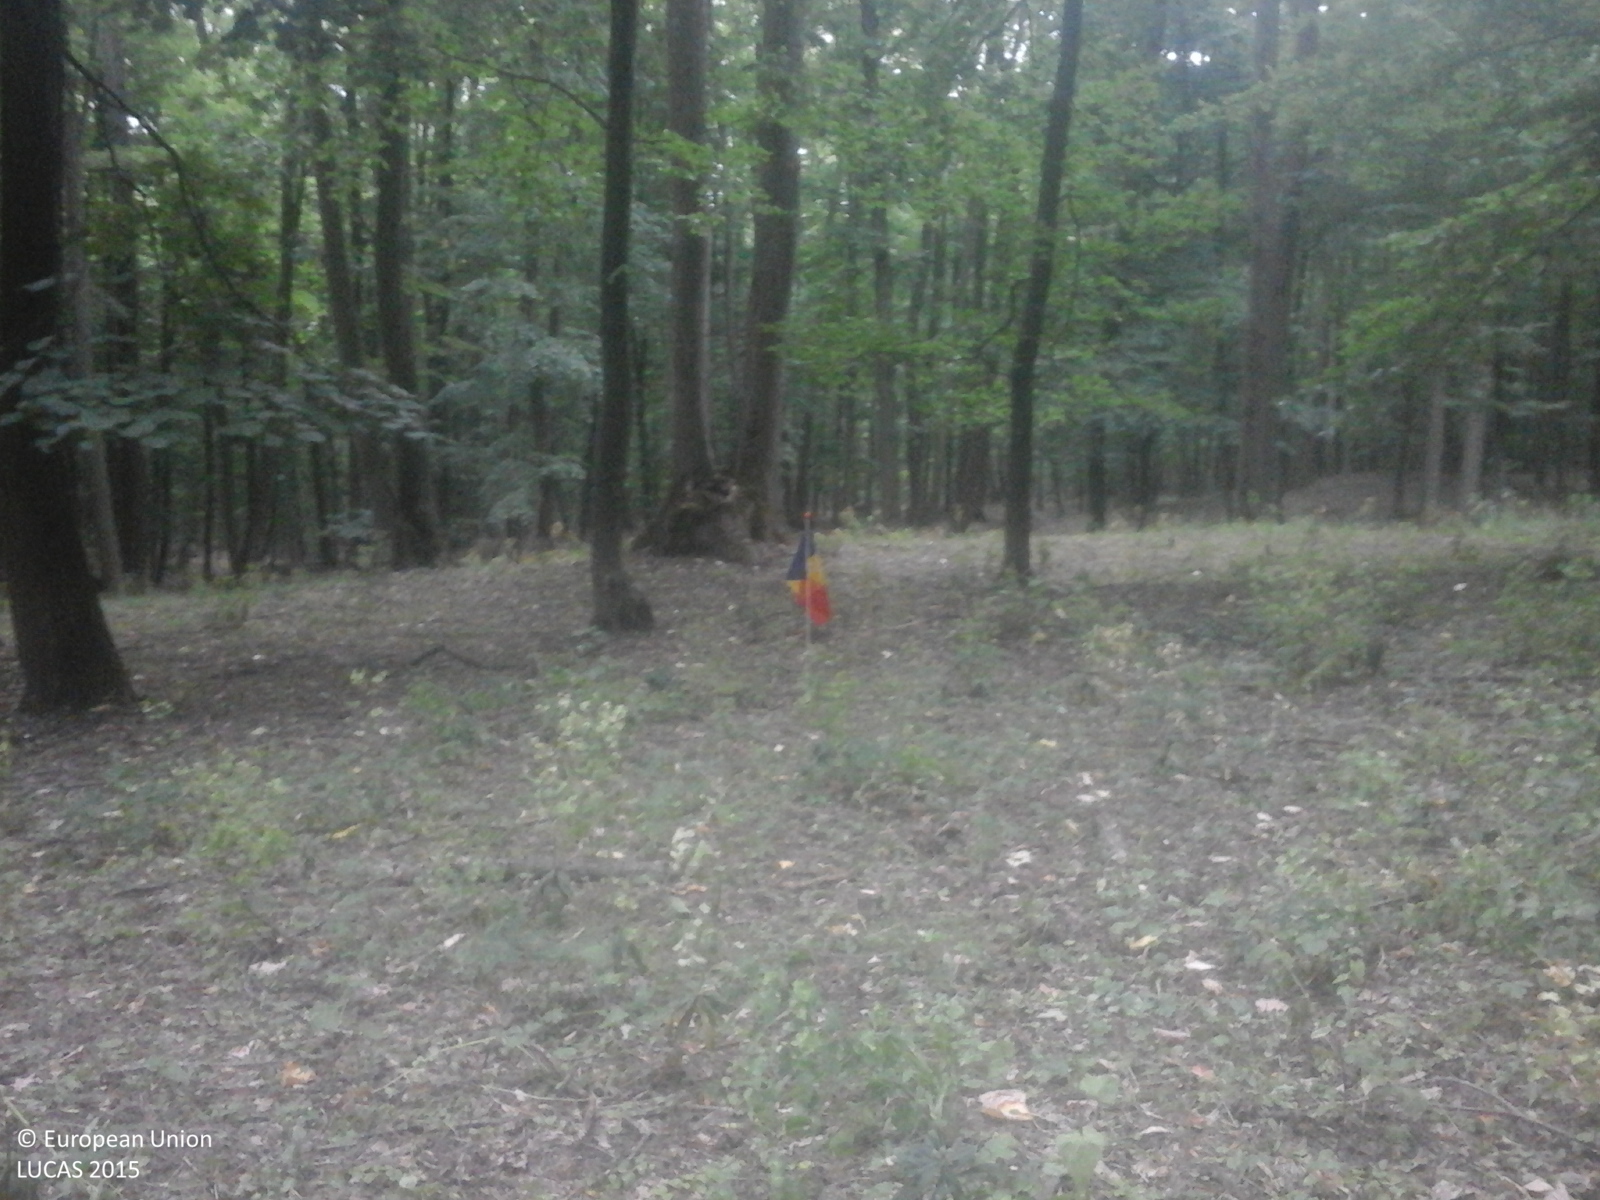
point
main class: Woodland
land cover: Broadleaved woodland
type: beech forest
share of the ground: > 75 %
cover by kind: broadleaved forest trees 95 %, herbaceous plants 5 %
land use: Forestry
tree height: > 5 m
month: June
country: RO
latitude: 47.6382
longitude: 26.8025
